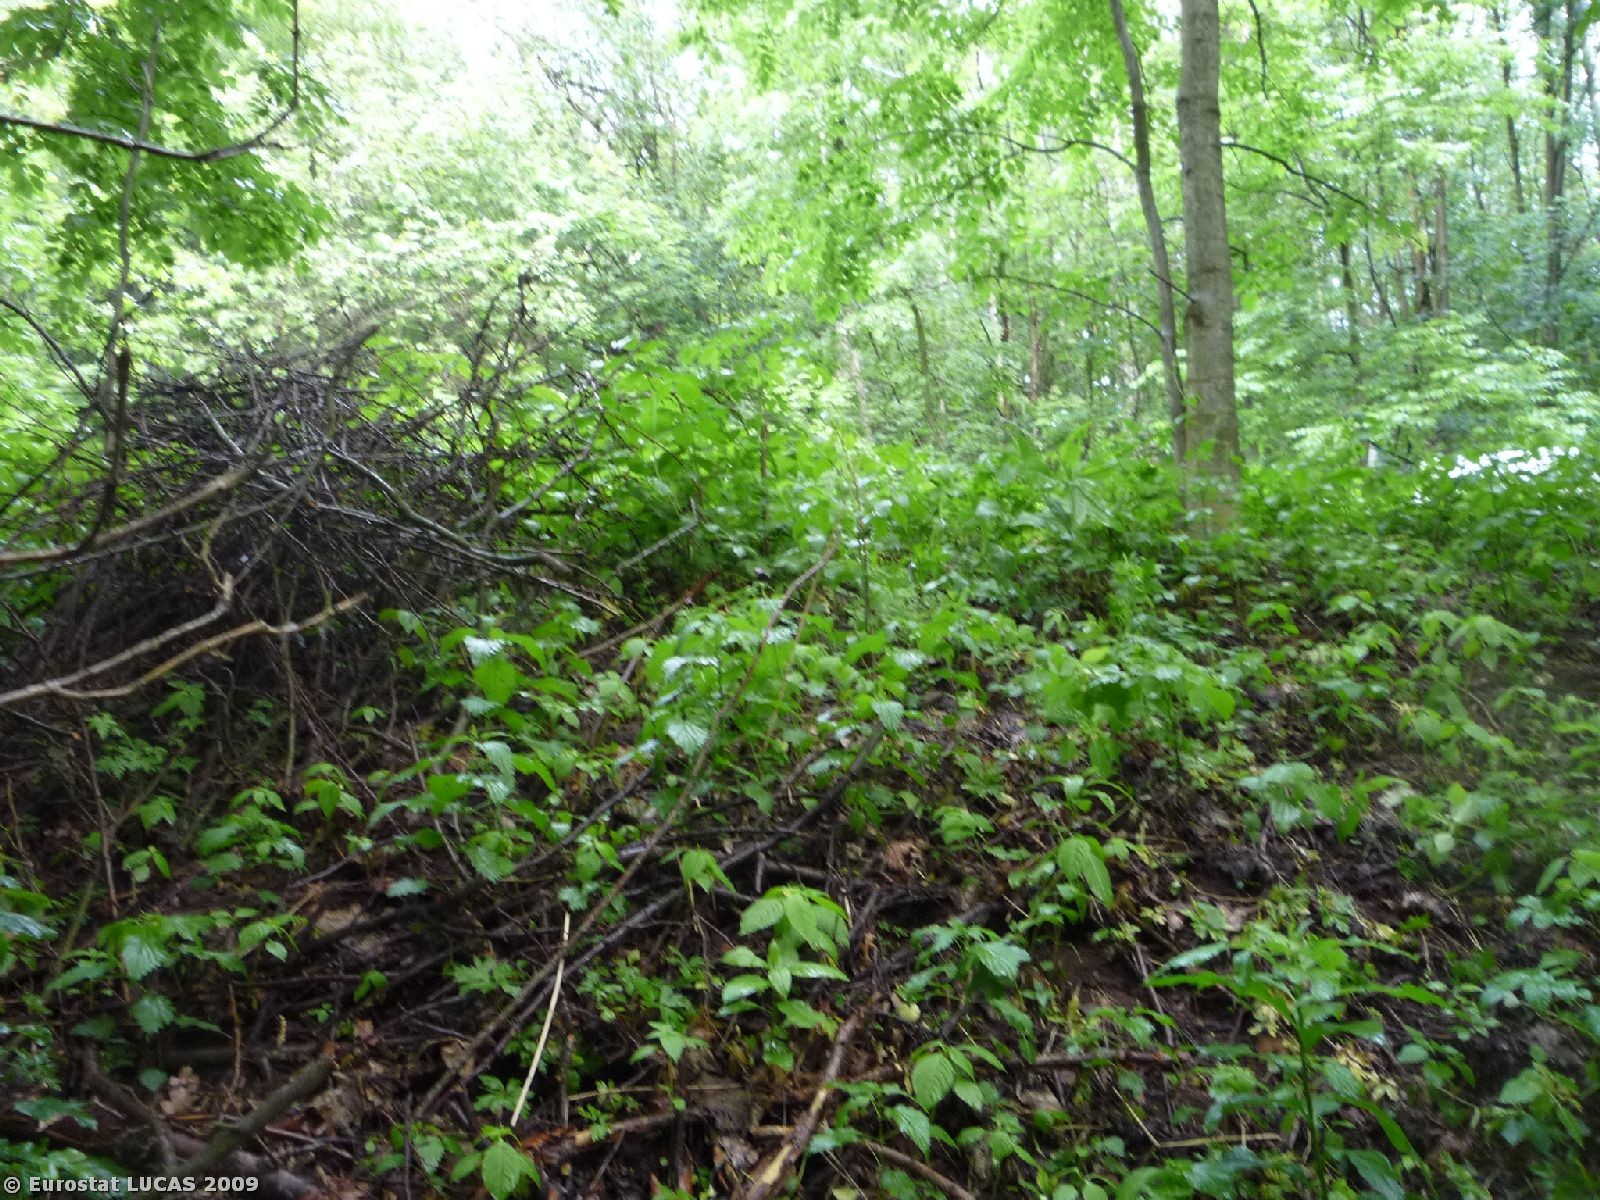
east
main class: Woodland
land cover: Broadleaved woodland
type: mesophytic deciduous forest
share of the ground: > 75 %
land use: Forestry
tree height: > 5 m
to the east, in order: Broadleaved woodland; Grassland without tree/shrub cover; Broadleaved woodland; Tracks; Coniferous woodland; Grassland without tree/shrub cover
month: June
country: CZ
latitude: 50.6254
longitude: 15.5598
